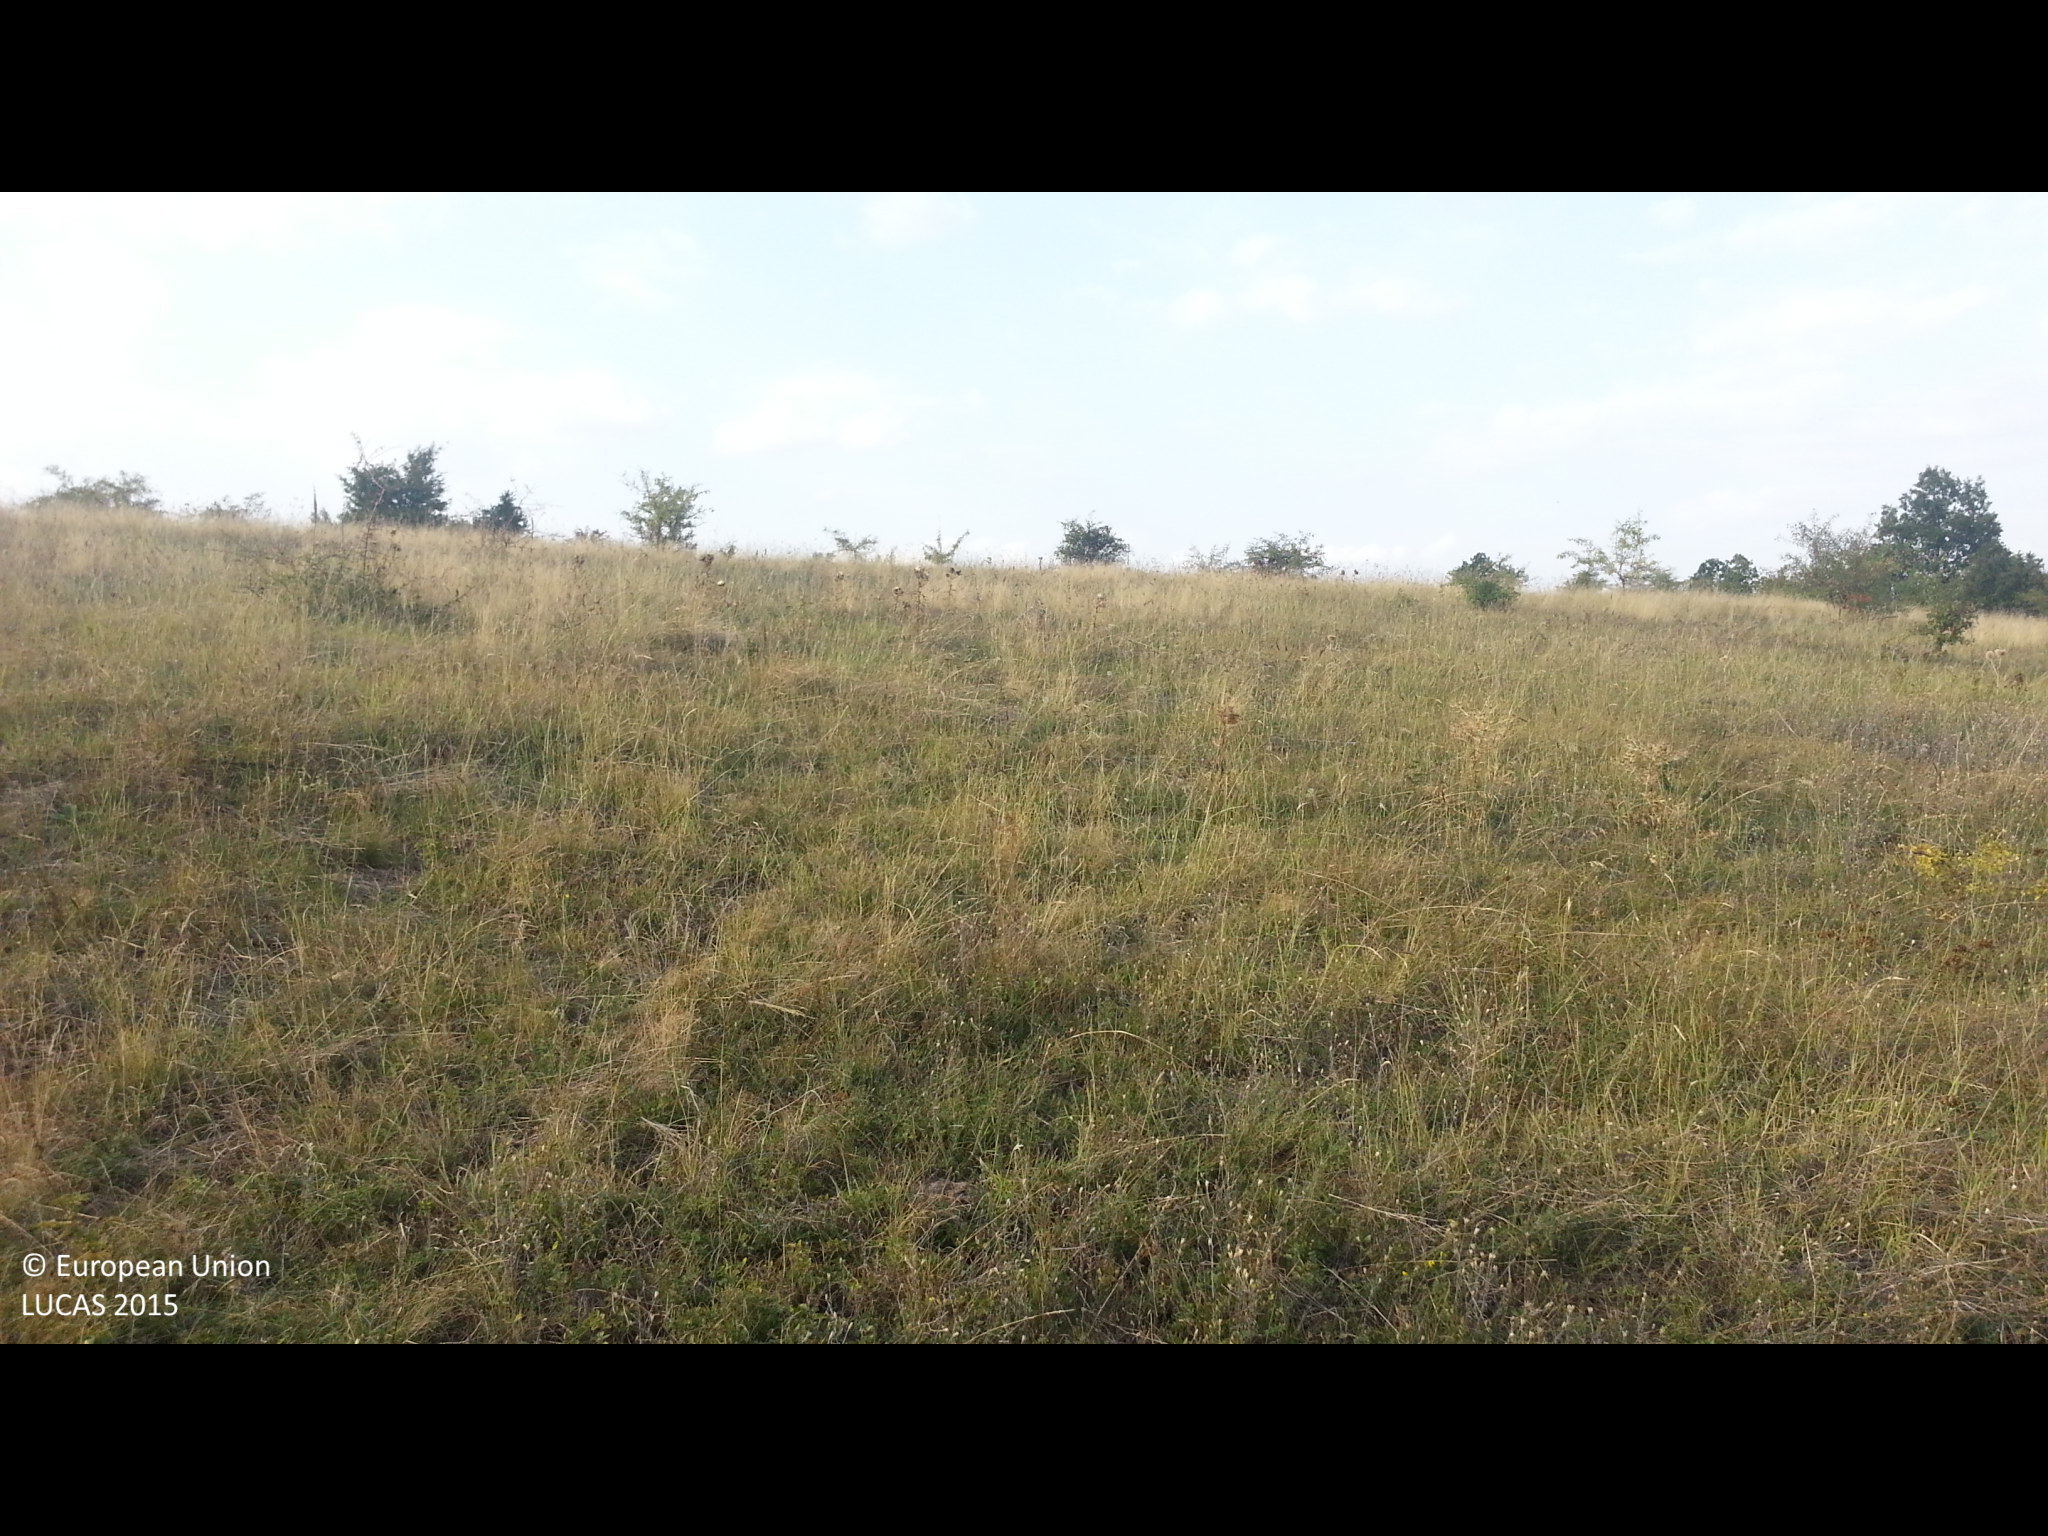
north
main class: Grassland
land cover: Grassland with sparse tree/shrub cover
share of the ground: > 75 %
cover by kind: herbaceous plants 90 %, broadleaved forest trees 5 %, shrubs 5 %
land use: Agriculture (excluding fallow land and kitchen gardens)
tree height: < 5 m
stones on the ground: < 10 %
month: September
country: BG
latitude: 42.5487
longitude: 23.0966
